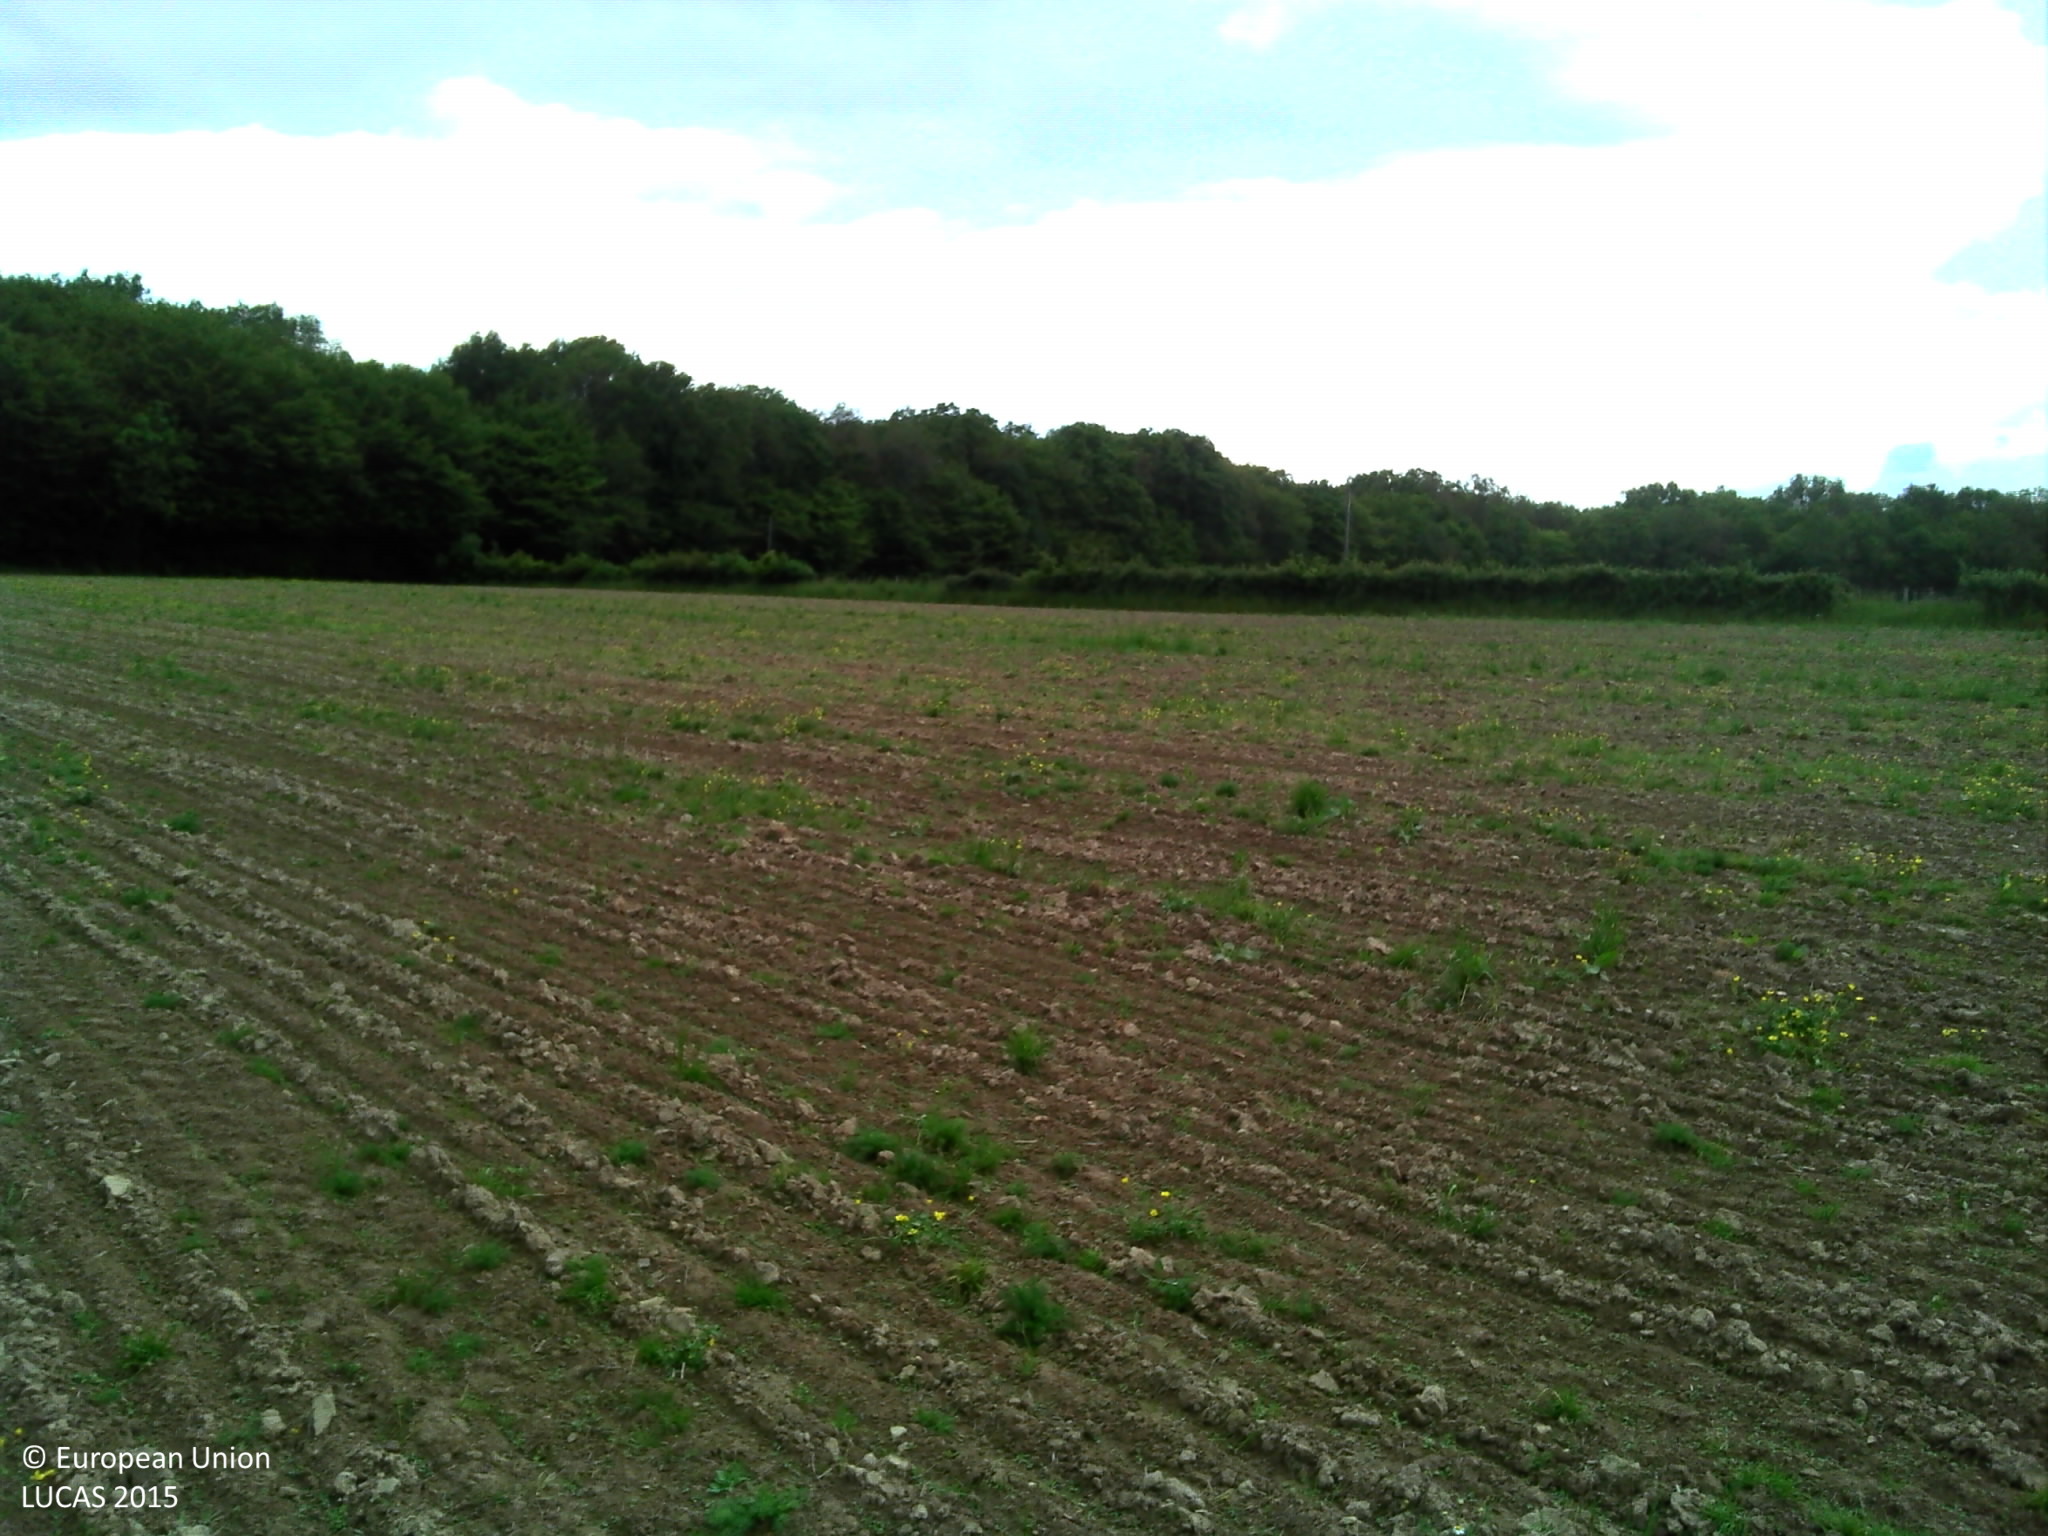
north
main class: Cropland
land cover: Soya
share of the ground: > 75 %
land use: Agriculture (excluding fallow land and kitchen gardens)
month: May
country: FR
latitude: 47.4490
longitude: 2.8453
